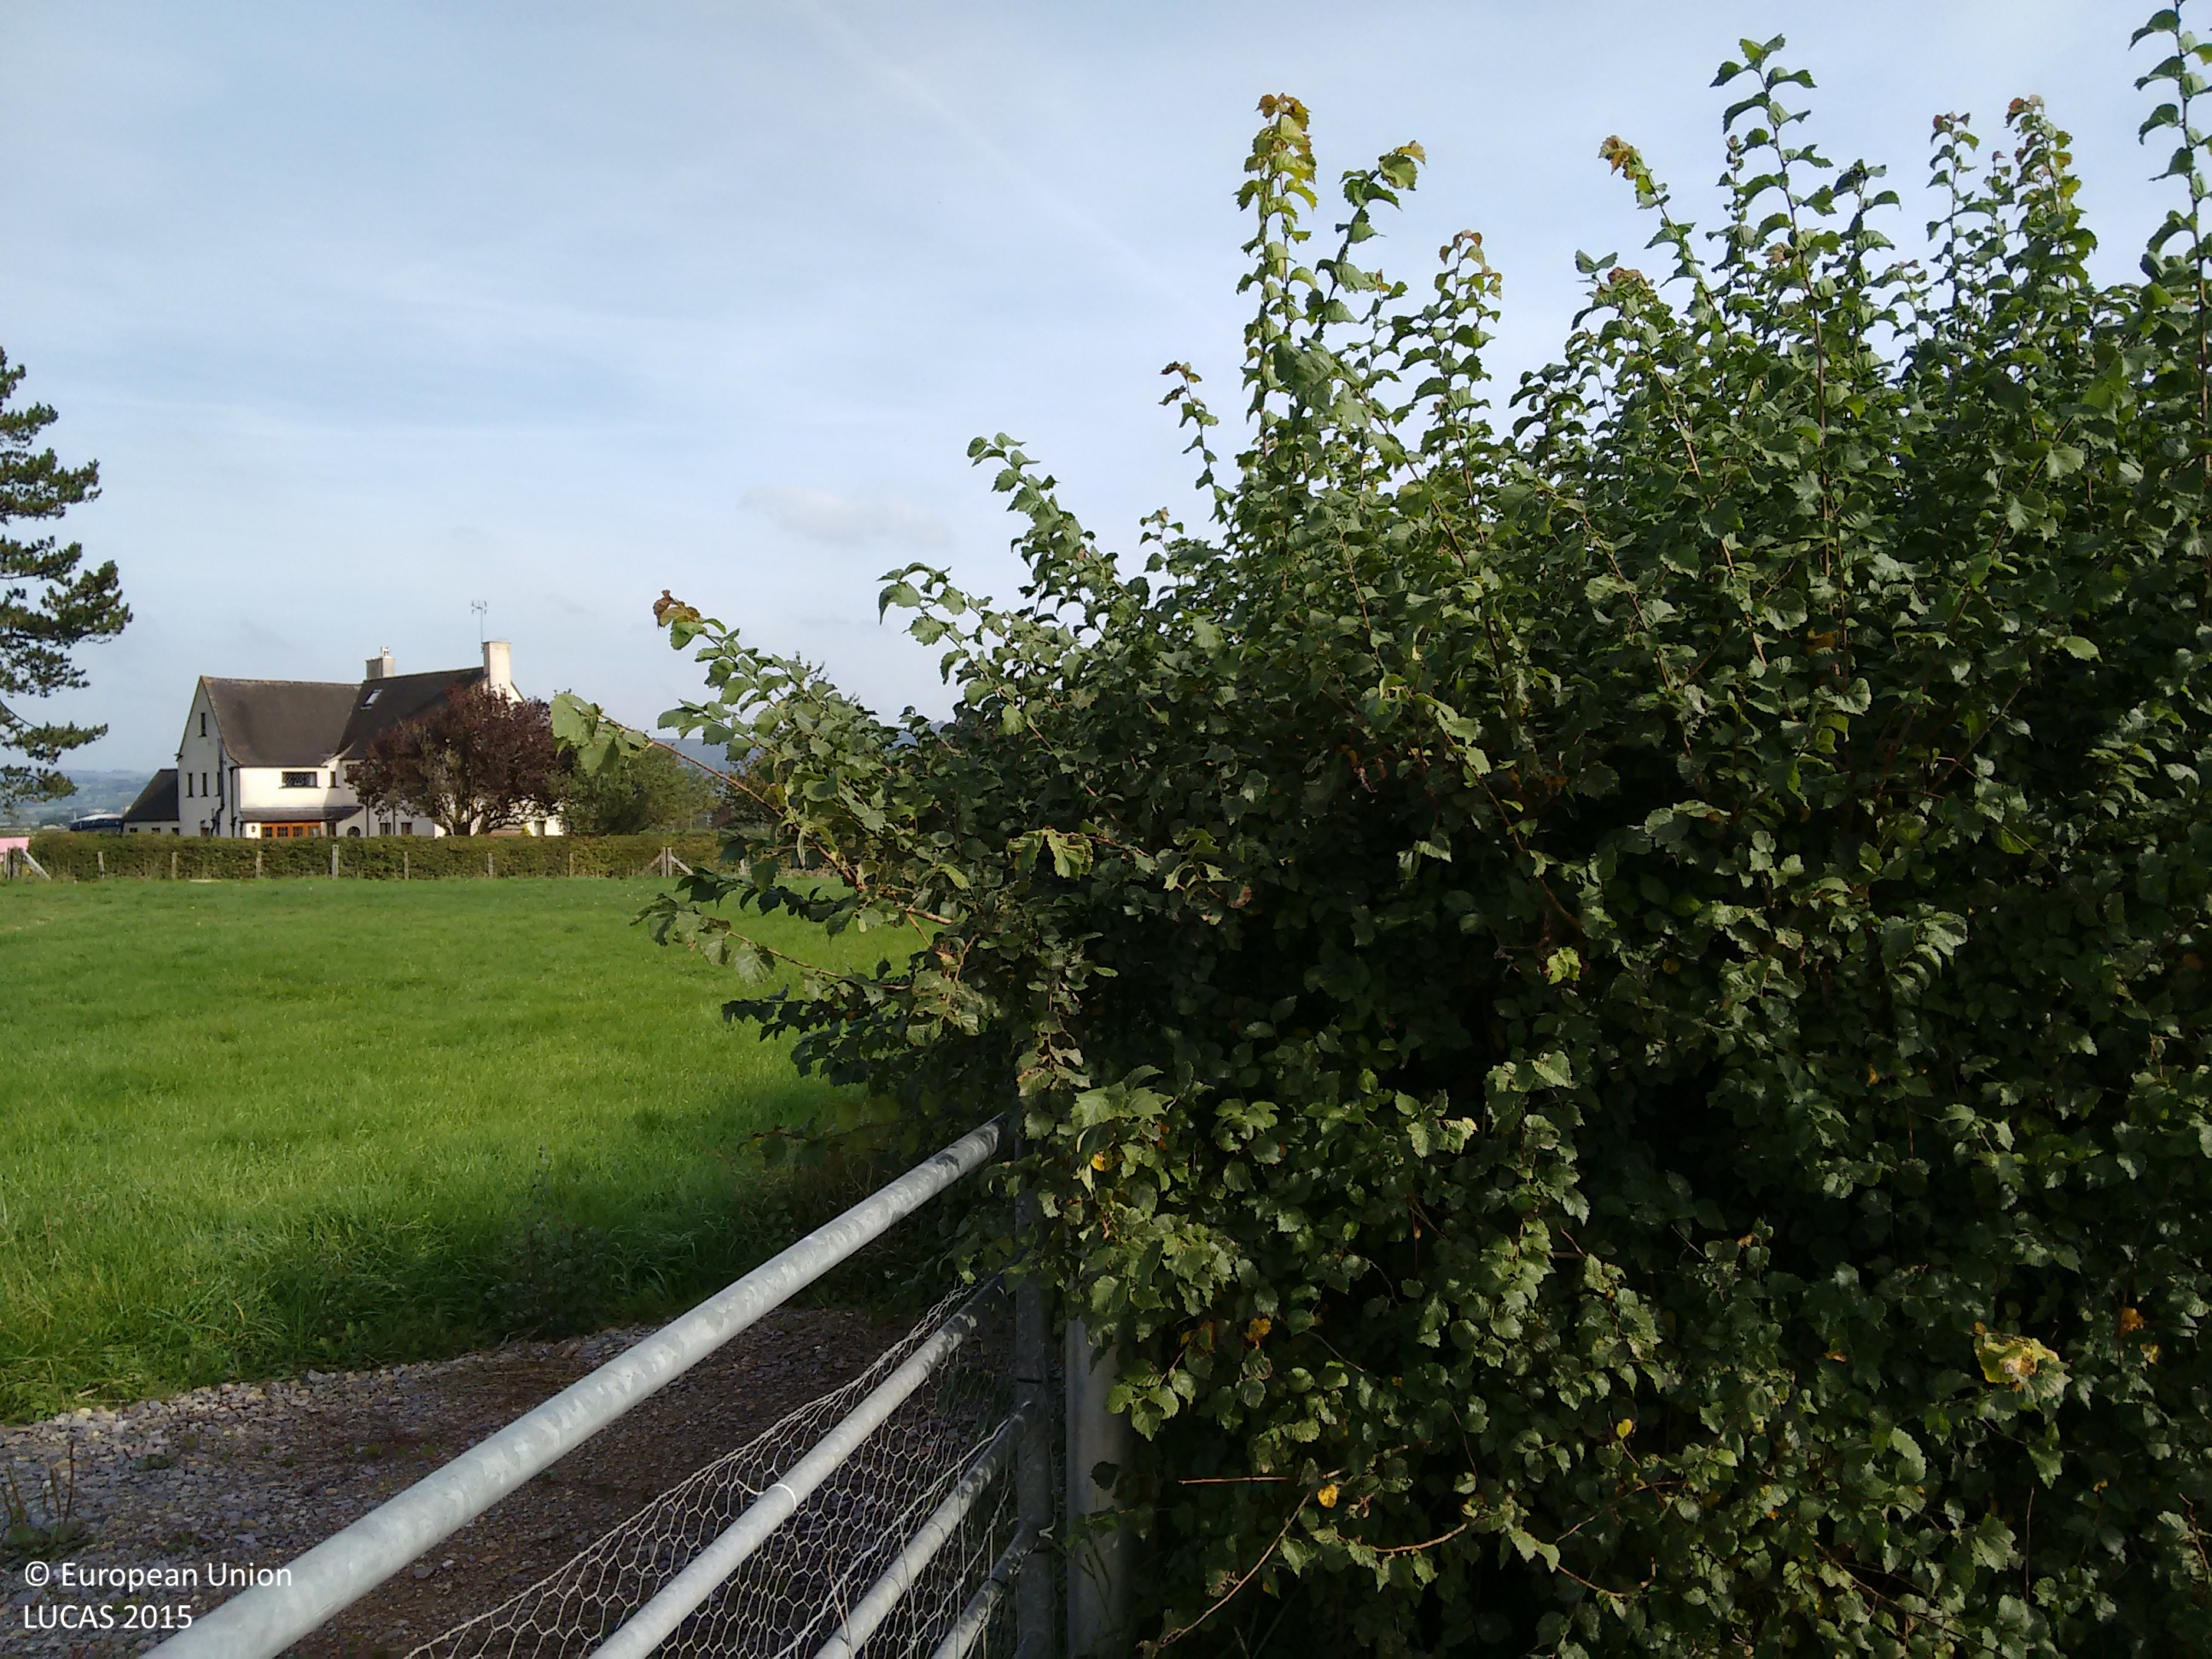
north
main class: Grassland
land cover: Grassland without tree/shrub cover
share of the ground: > 75 %
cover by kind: herbaceous plants 100 %
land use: Agriculture (excluding fallow land and kitchen gardens)
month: September
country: GB
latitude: 51.6167
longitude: -2.3840
